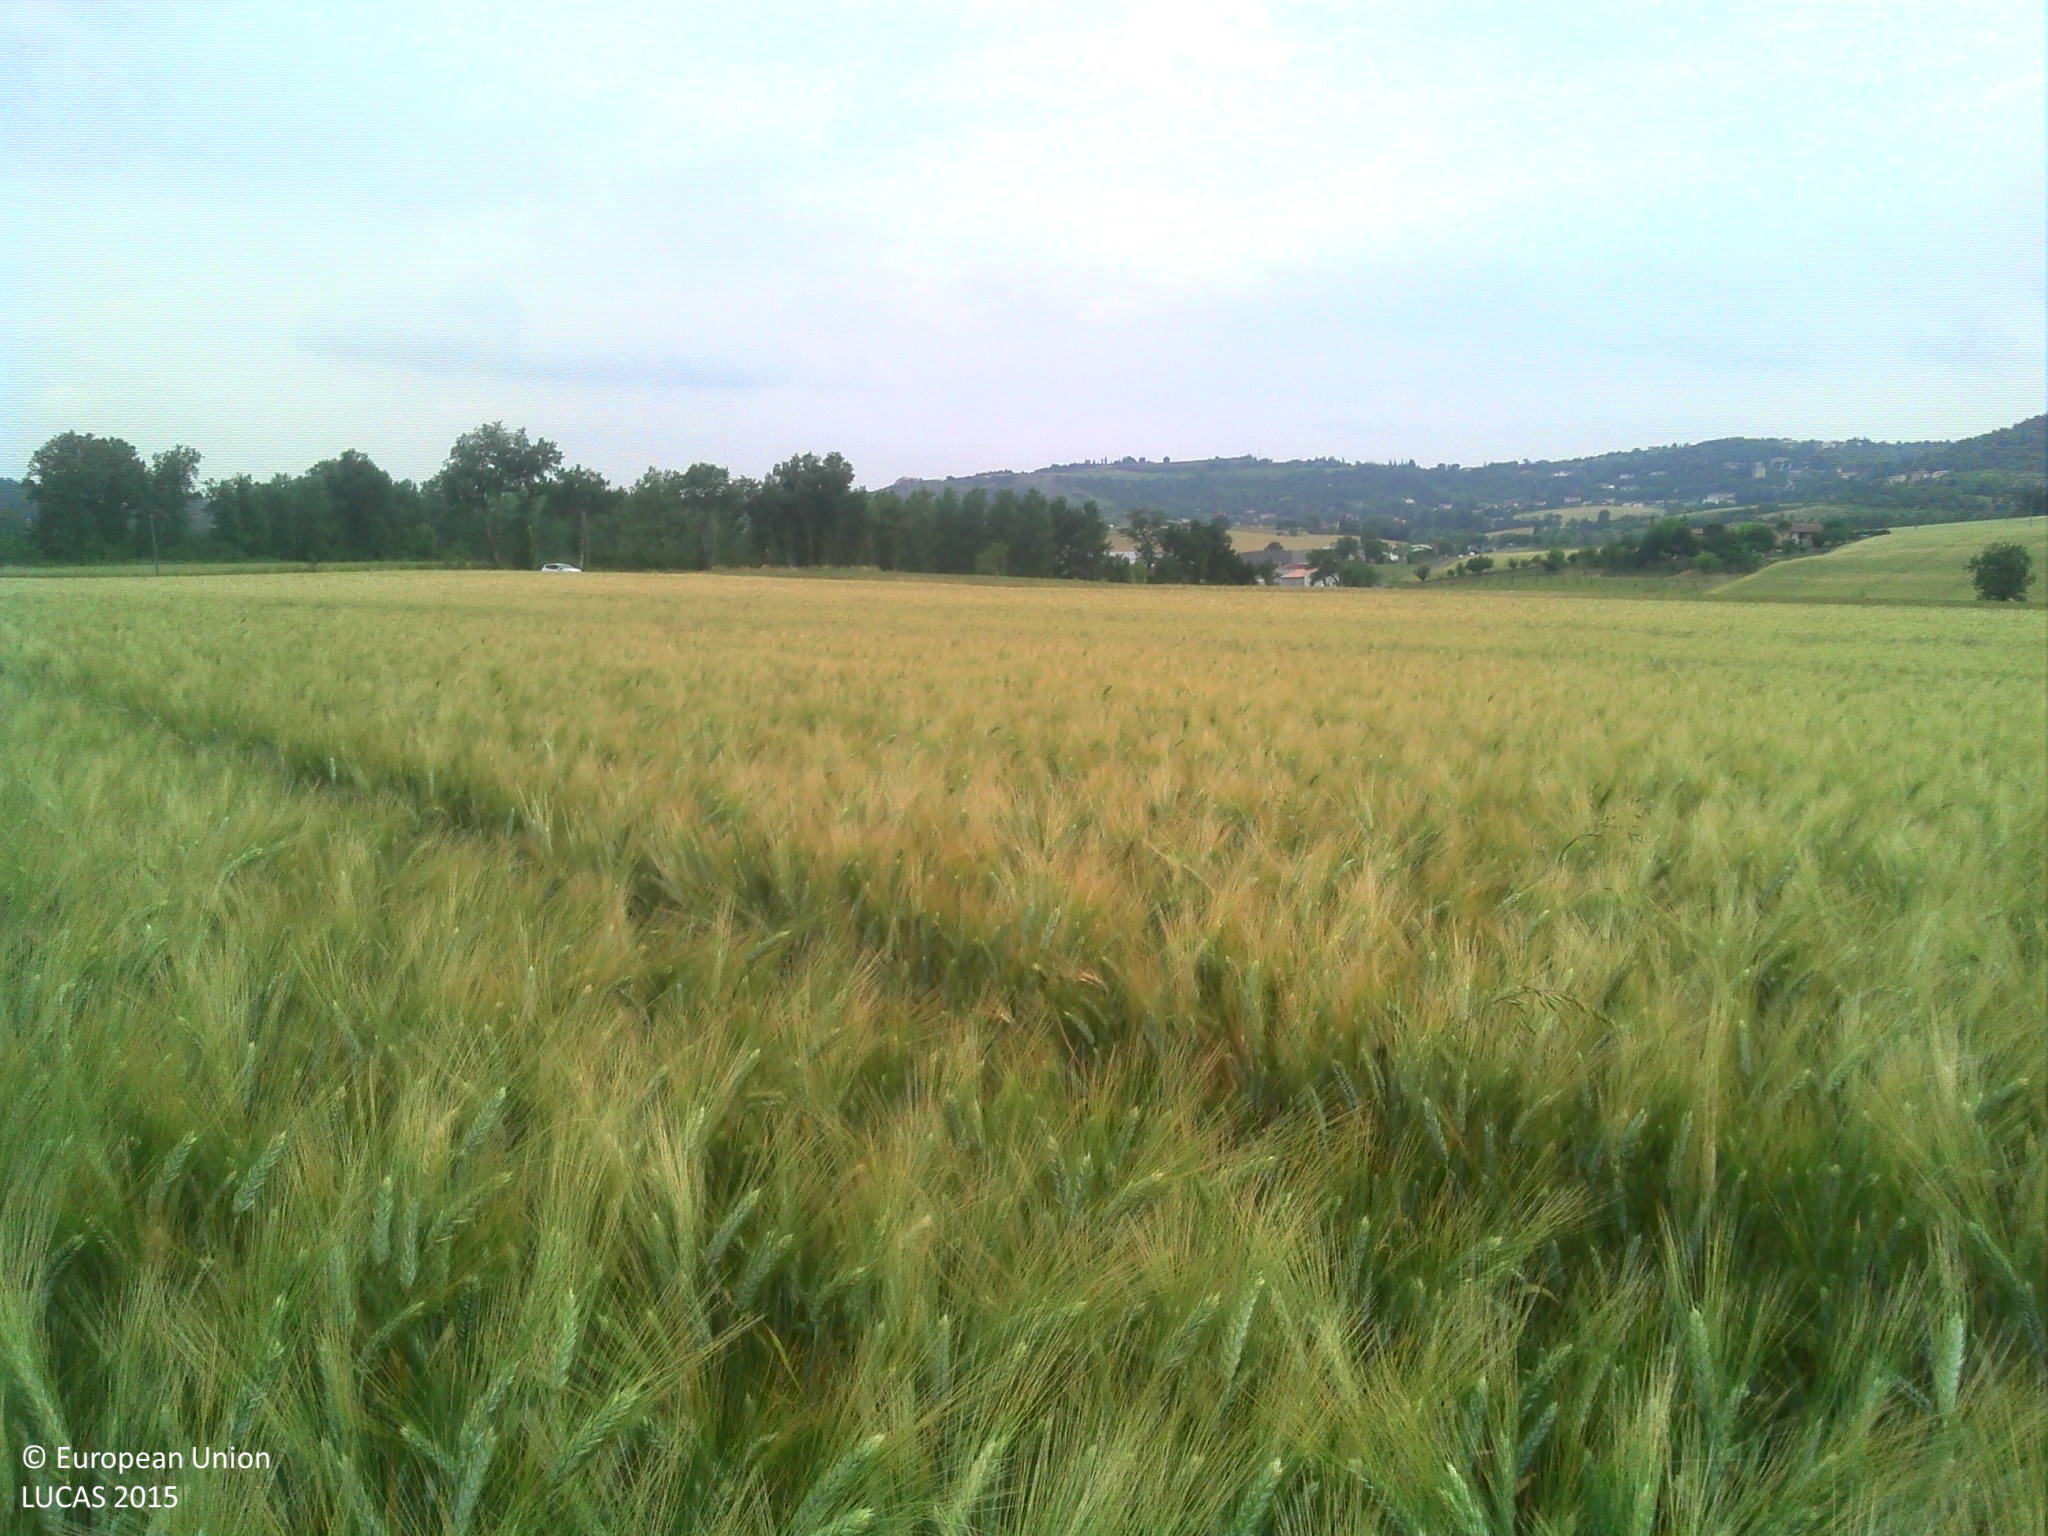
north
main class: Cropland
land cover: Common wheat
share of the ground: > 75 %
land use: Agriculture (excluding fallow land and kitchen gardens)
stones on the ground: 10 - 25 %
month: June
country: FR
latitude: 43.6888
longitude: 2.1270
